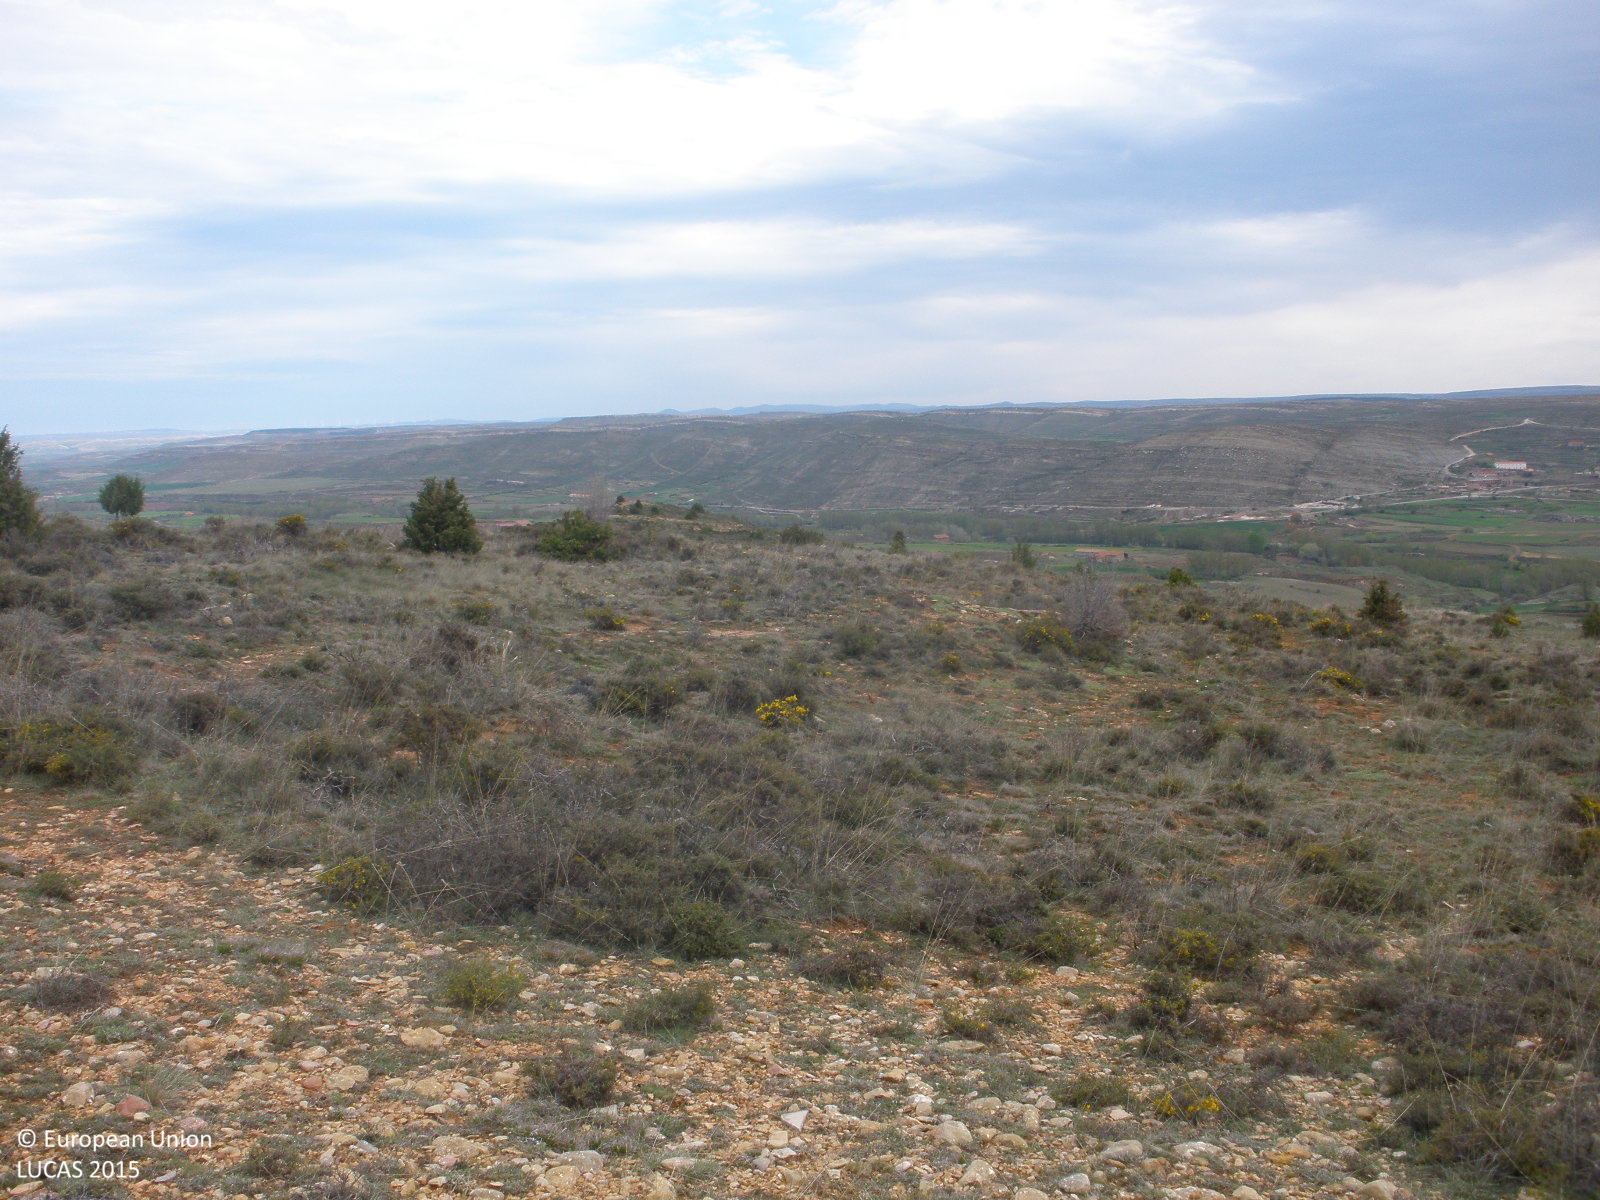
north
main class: Shrubland
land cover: Shrubland without tree cover
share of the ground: 25 - 50 %
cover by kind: herbaceous plants 50 %, shrubs 40 %, consolidated bare surface 10 %
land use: Semi-natural and natural areas not in use
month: May
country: ES
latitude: 40.4766
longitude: -0.7555
